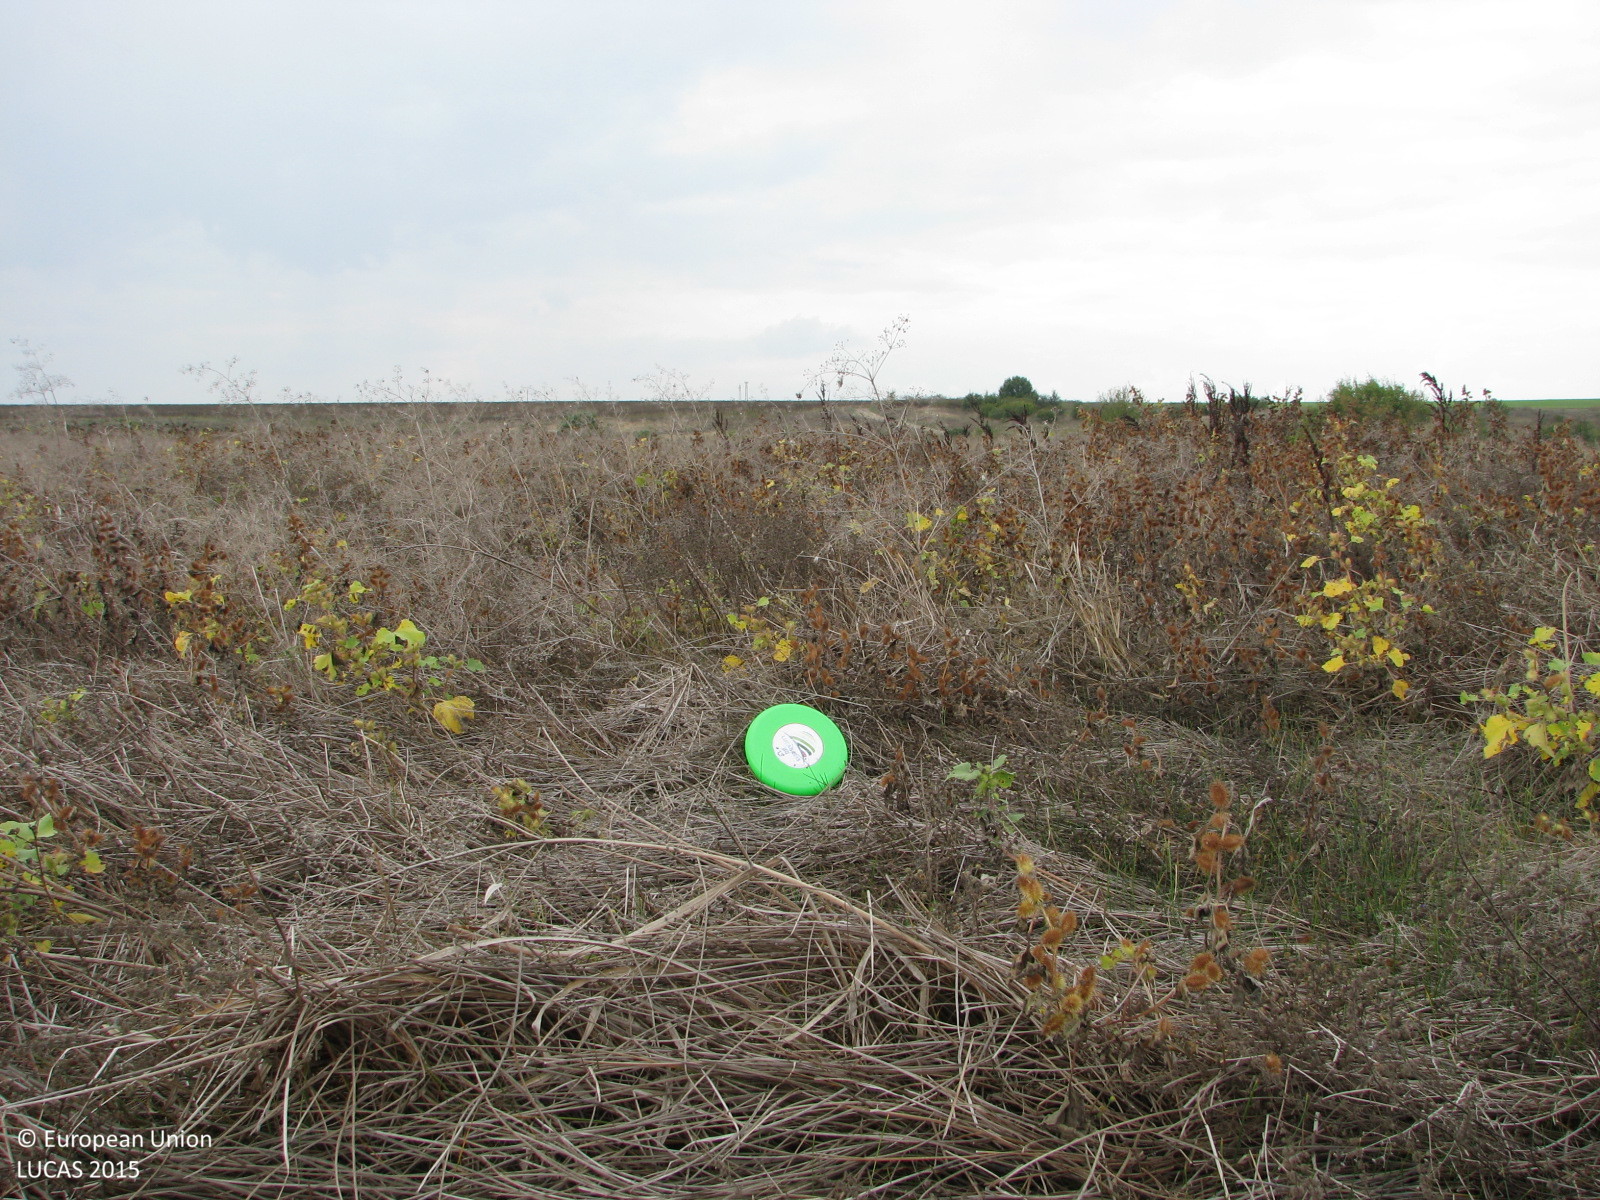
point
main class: Grassland
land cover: Spontaneously vegetated surfaces
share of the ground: > 75 %
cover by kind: herbaceous plants 100 %
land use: Fallow land
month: October
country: BG
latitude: 42.2602
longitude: 26.4160
